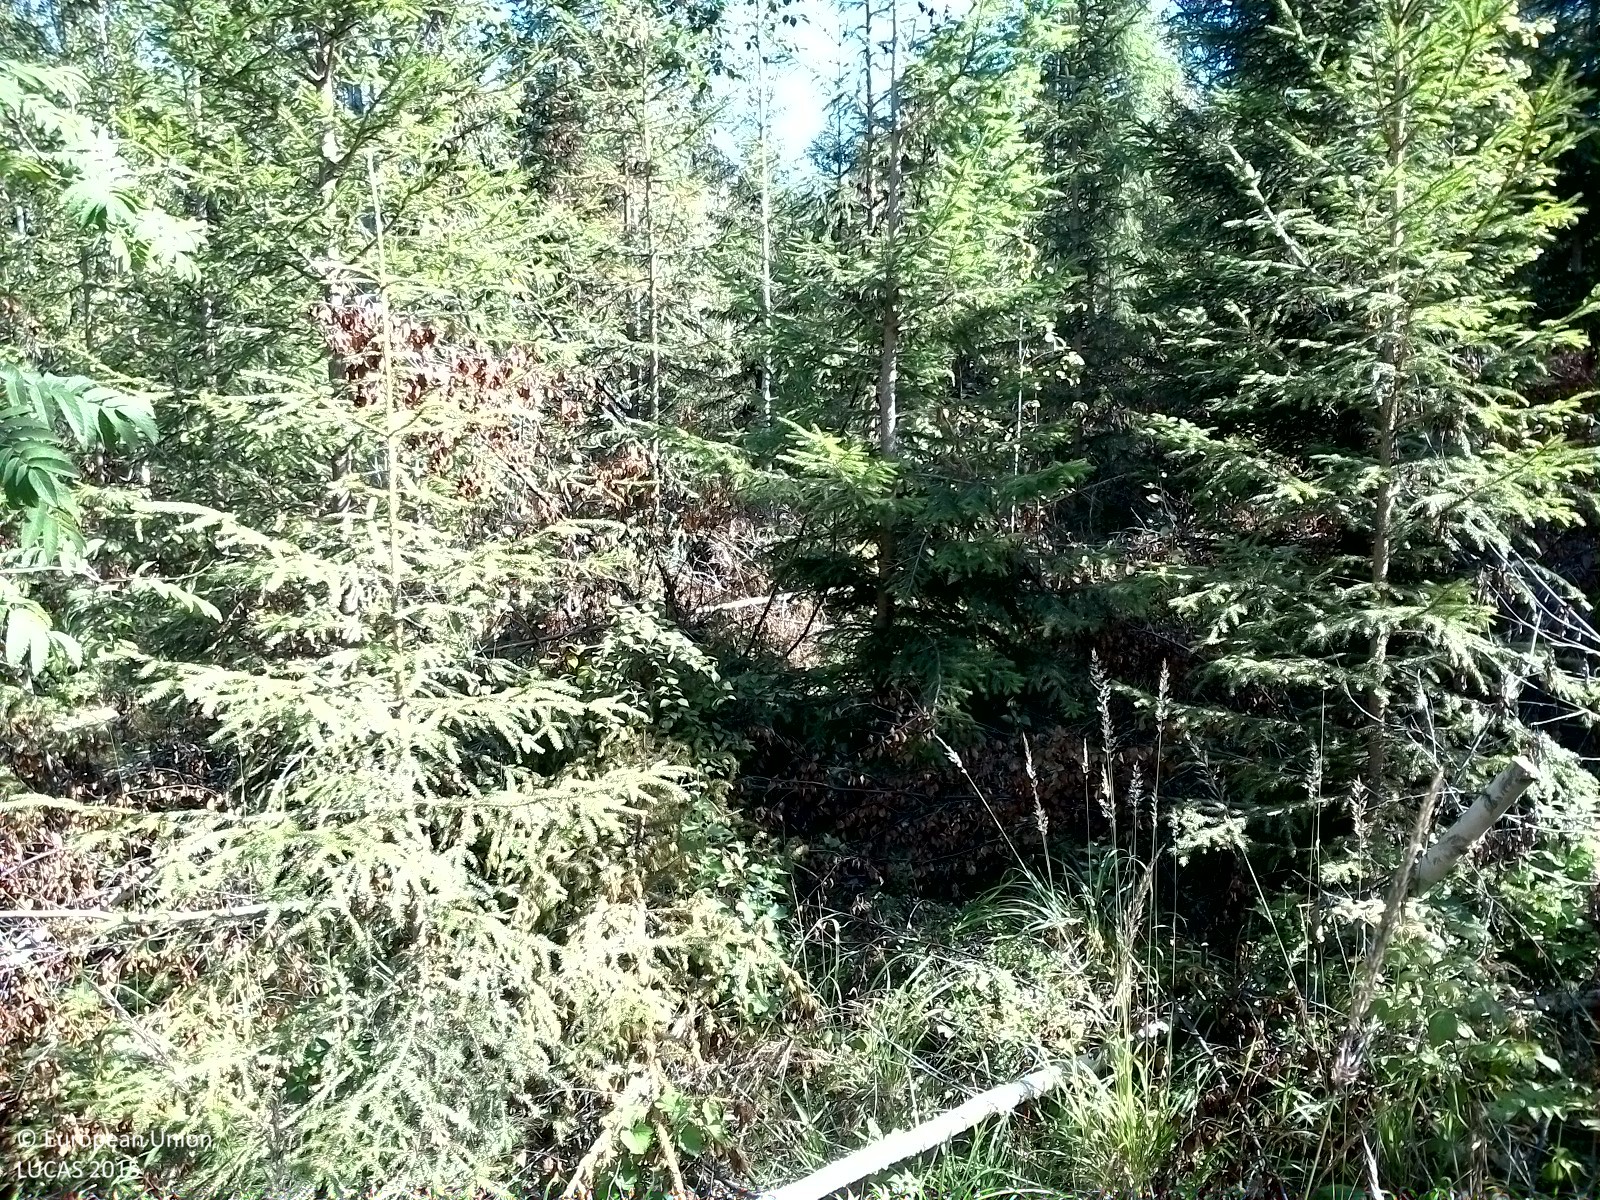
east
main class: Woodland
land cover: Spruce dominated mixed woodland
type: boreal forest
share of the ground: 50 - 75 %
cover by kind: coniferous forest trees 40 %, herbaceous plants 25 %, broadleaved forest trees 20 %, shrubs 15 %
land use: Forestry
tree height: < 5 m
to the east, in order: Spruce dominated mixed woodland; Other mixed woodland; Broadleaved woodland; Spruce dominated mixed woodland; Broadleaved woodland; Spruce dominated mixed woodland; Broadleaved woodland; Grassland without tree/shrub cover
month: August
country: SE
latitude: 62.4192
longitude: 16.4653
